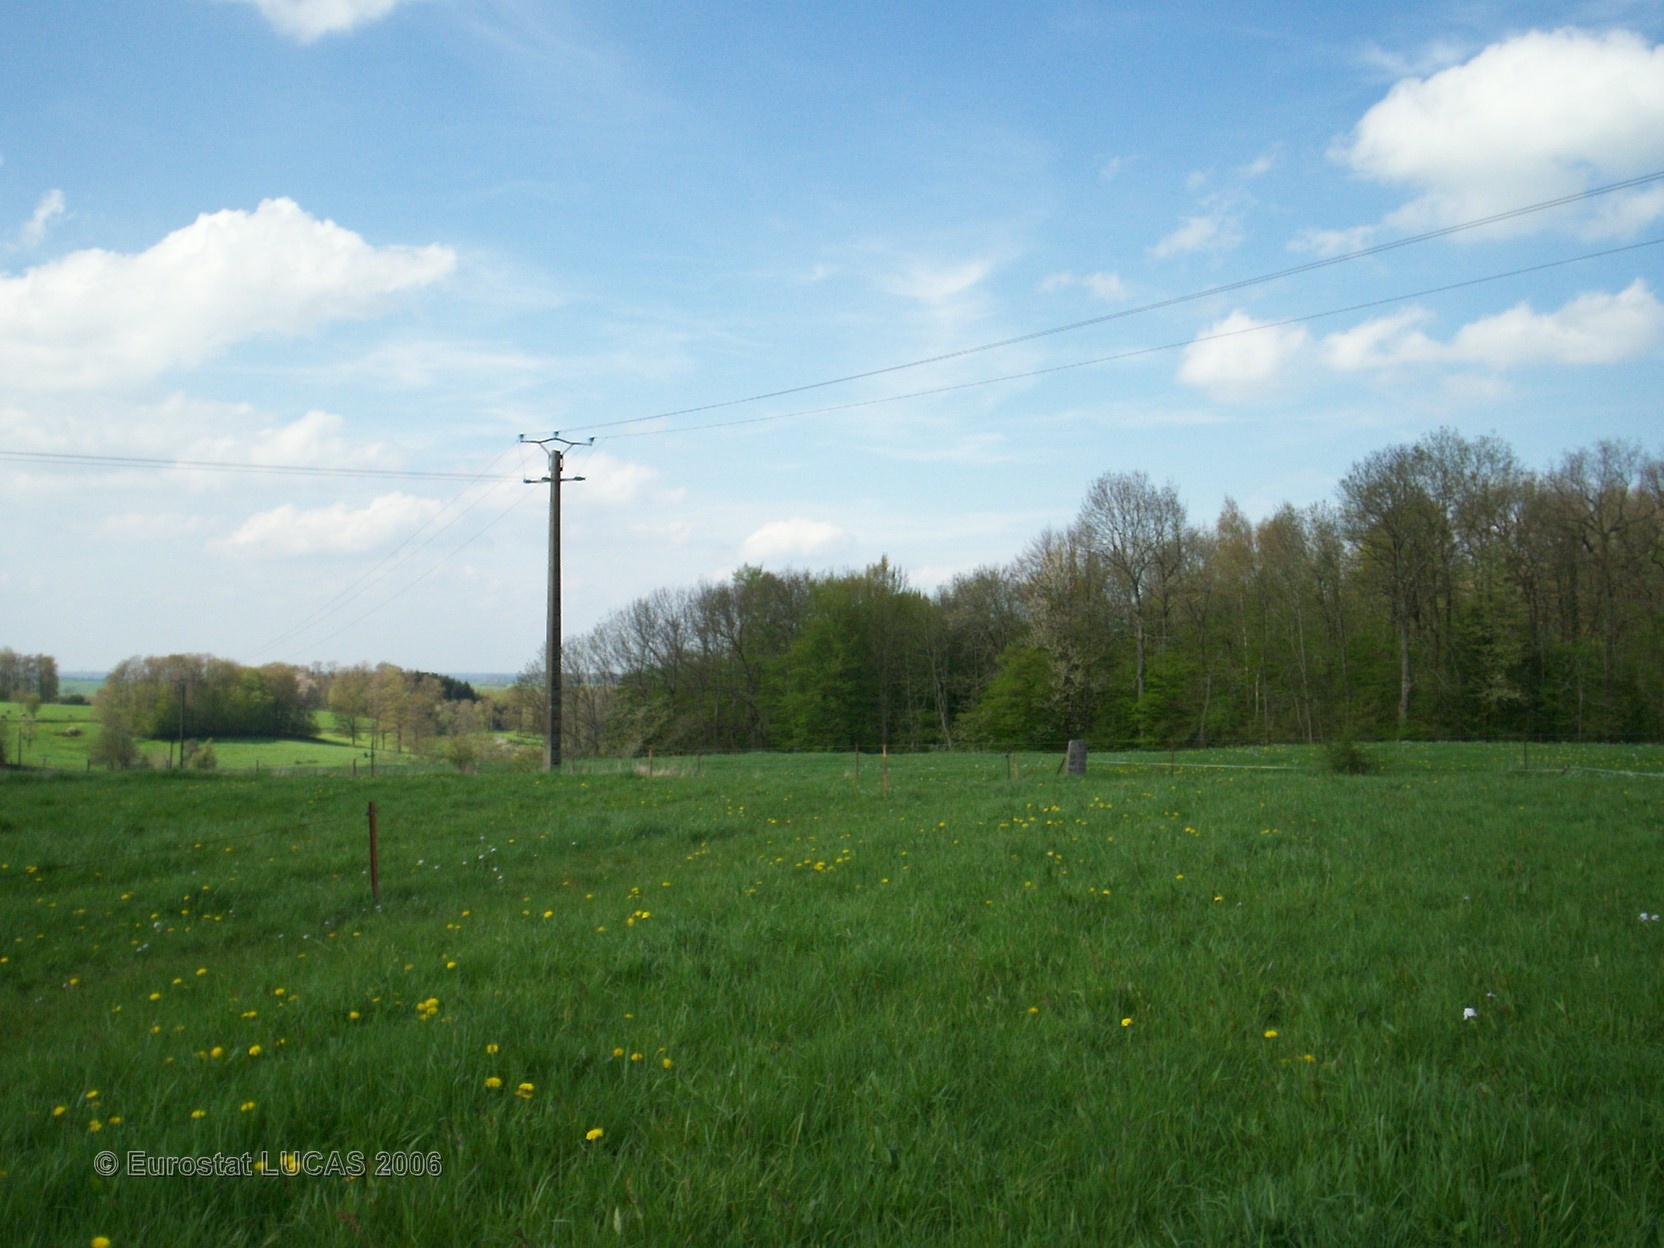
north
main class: Grassland
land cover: Grassland without tree/shrub cover
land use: Agriculture (excluding fallow land and kitchen gardens)
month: May
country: FR
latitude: 49.7886
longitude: 4.2866
